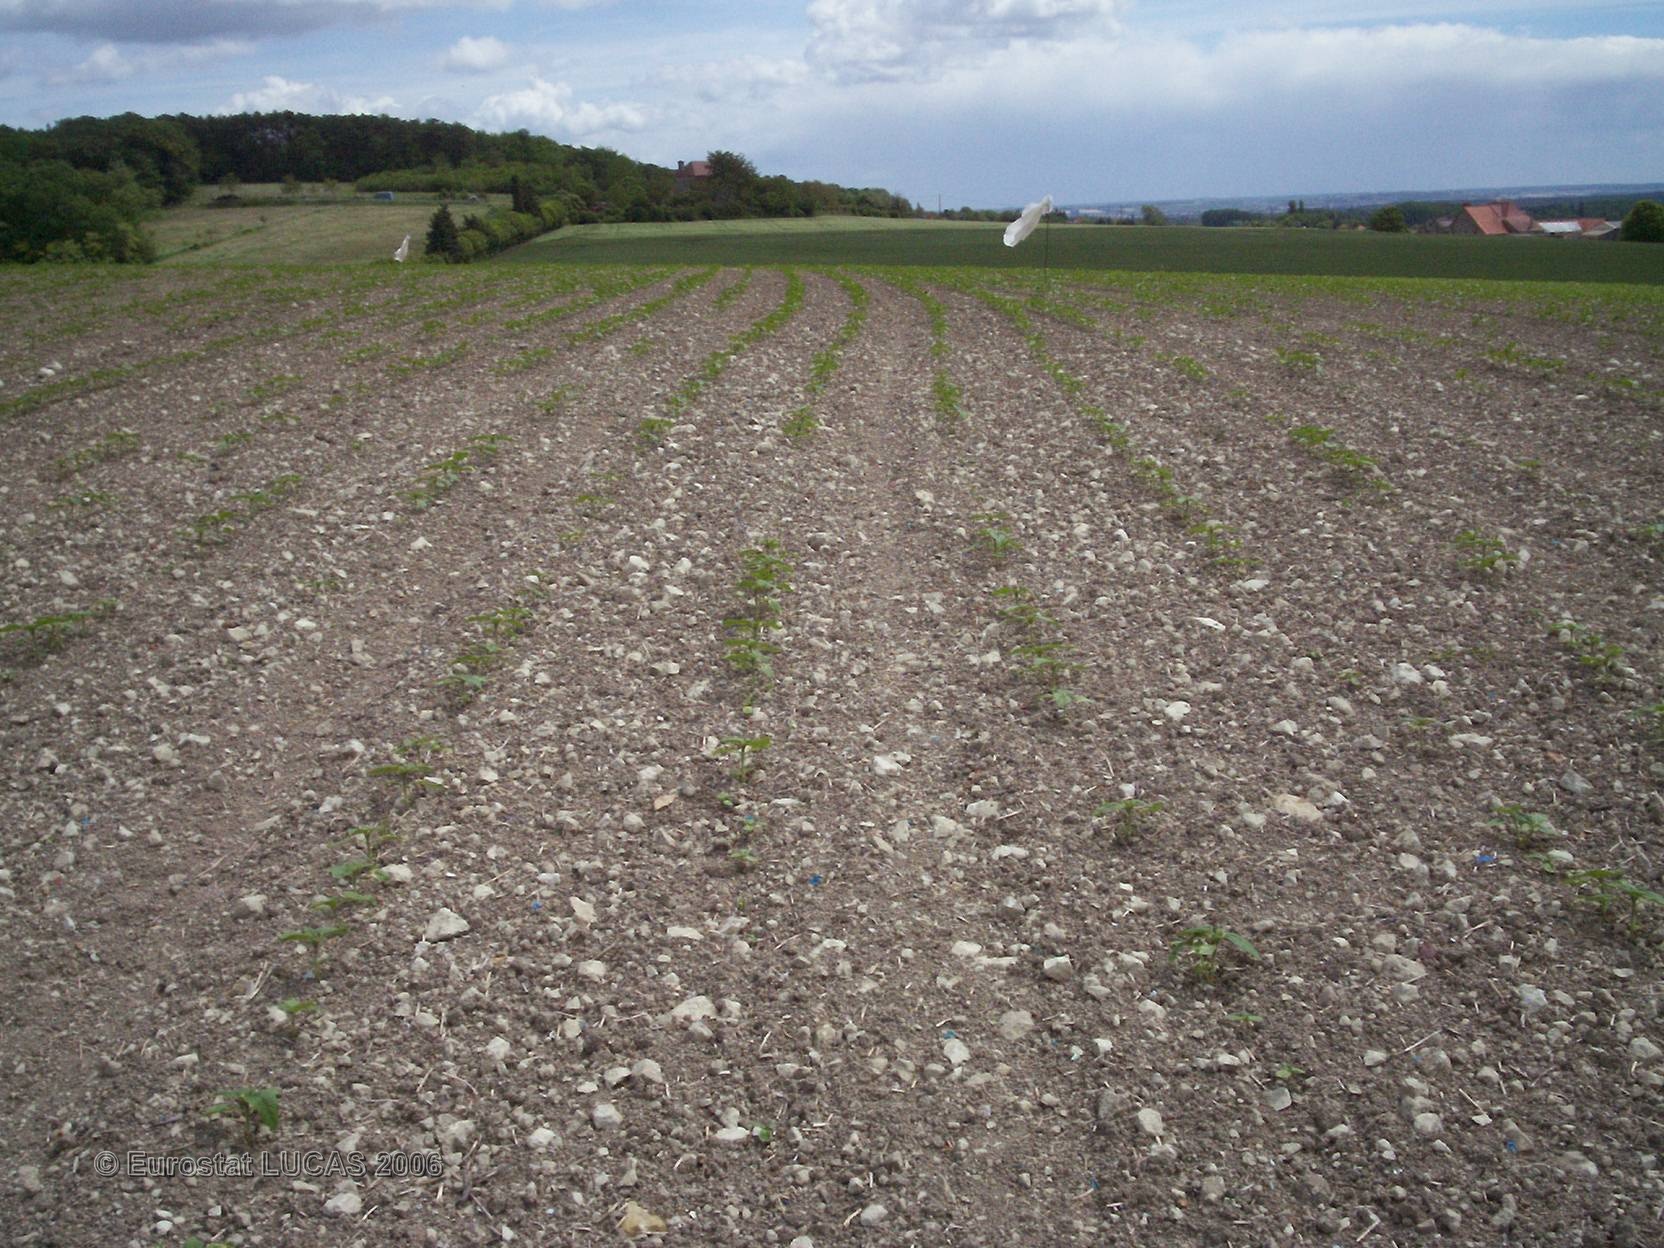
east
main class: Cropland
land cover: Sunflower
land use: Agriculture (excluding fallow land and kitchen gardens)
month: May
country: FR
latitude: 46.8272
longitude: 0.4241
